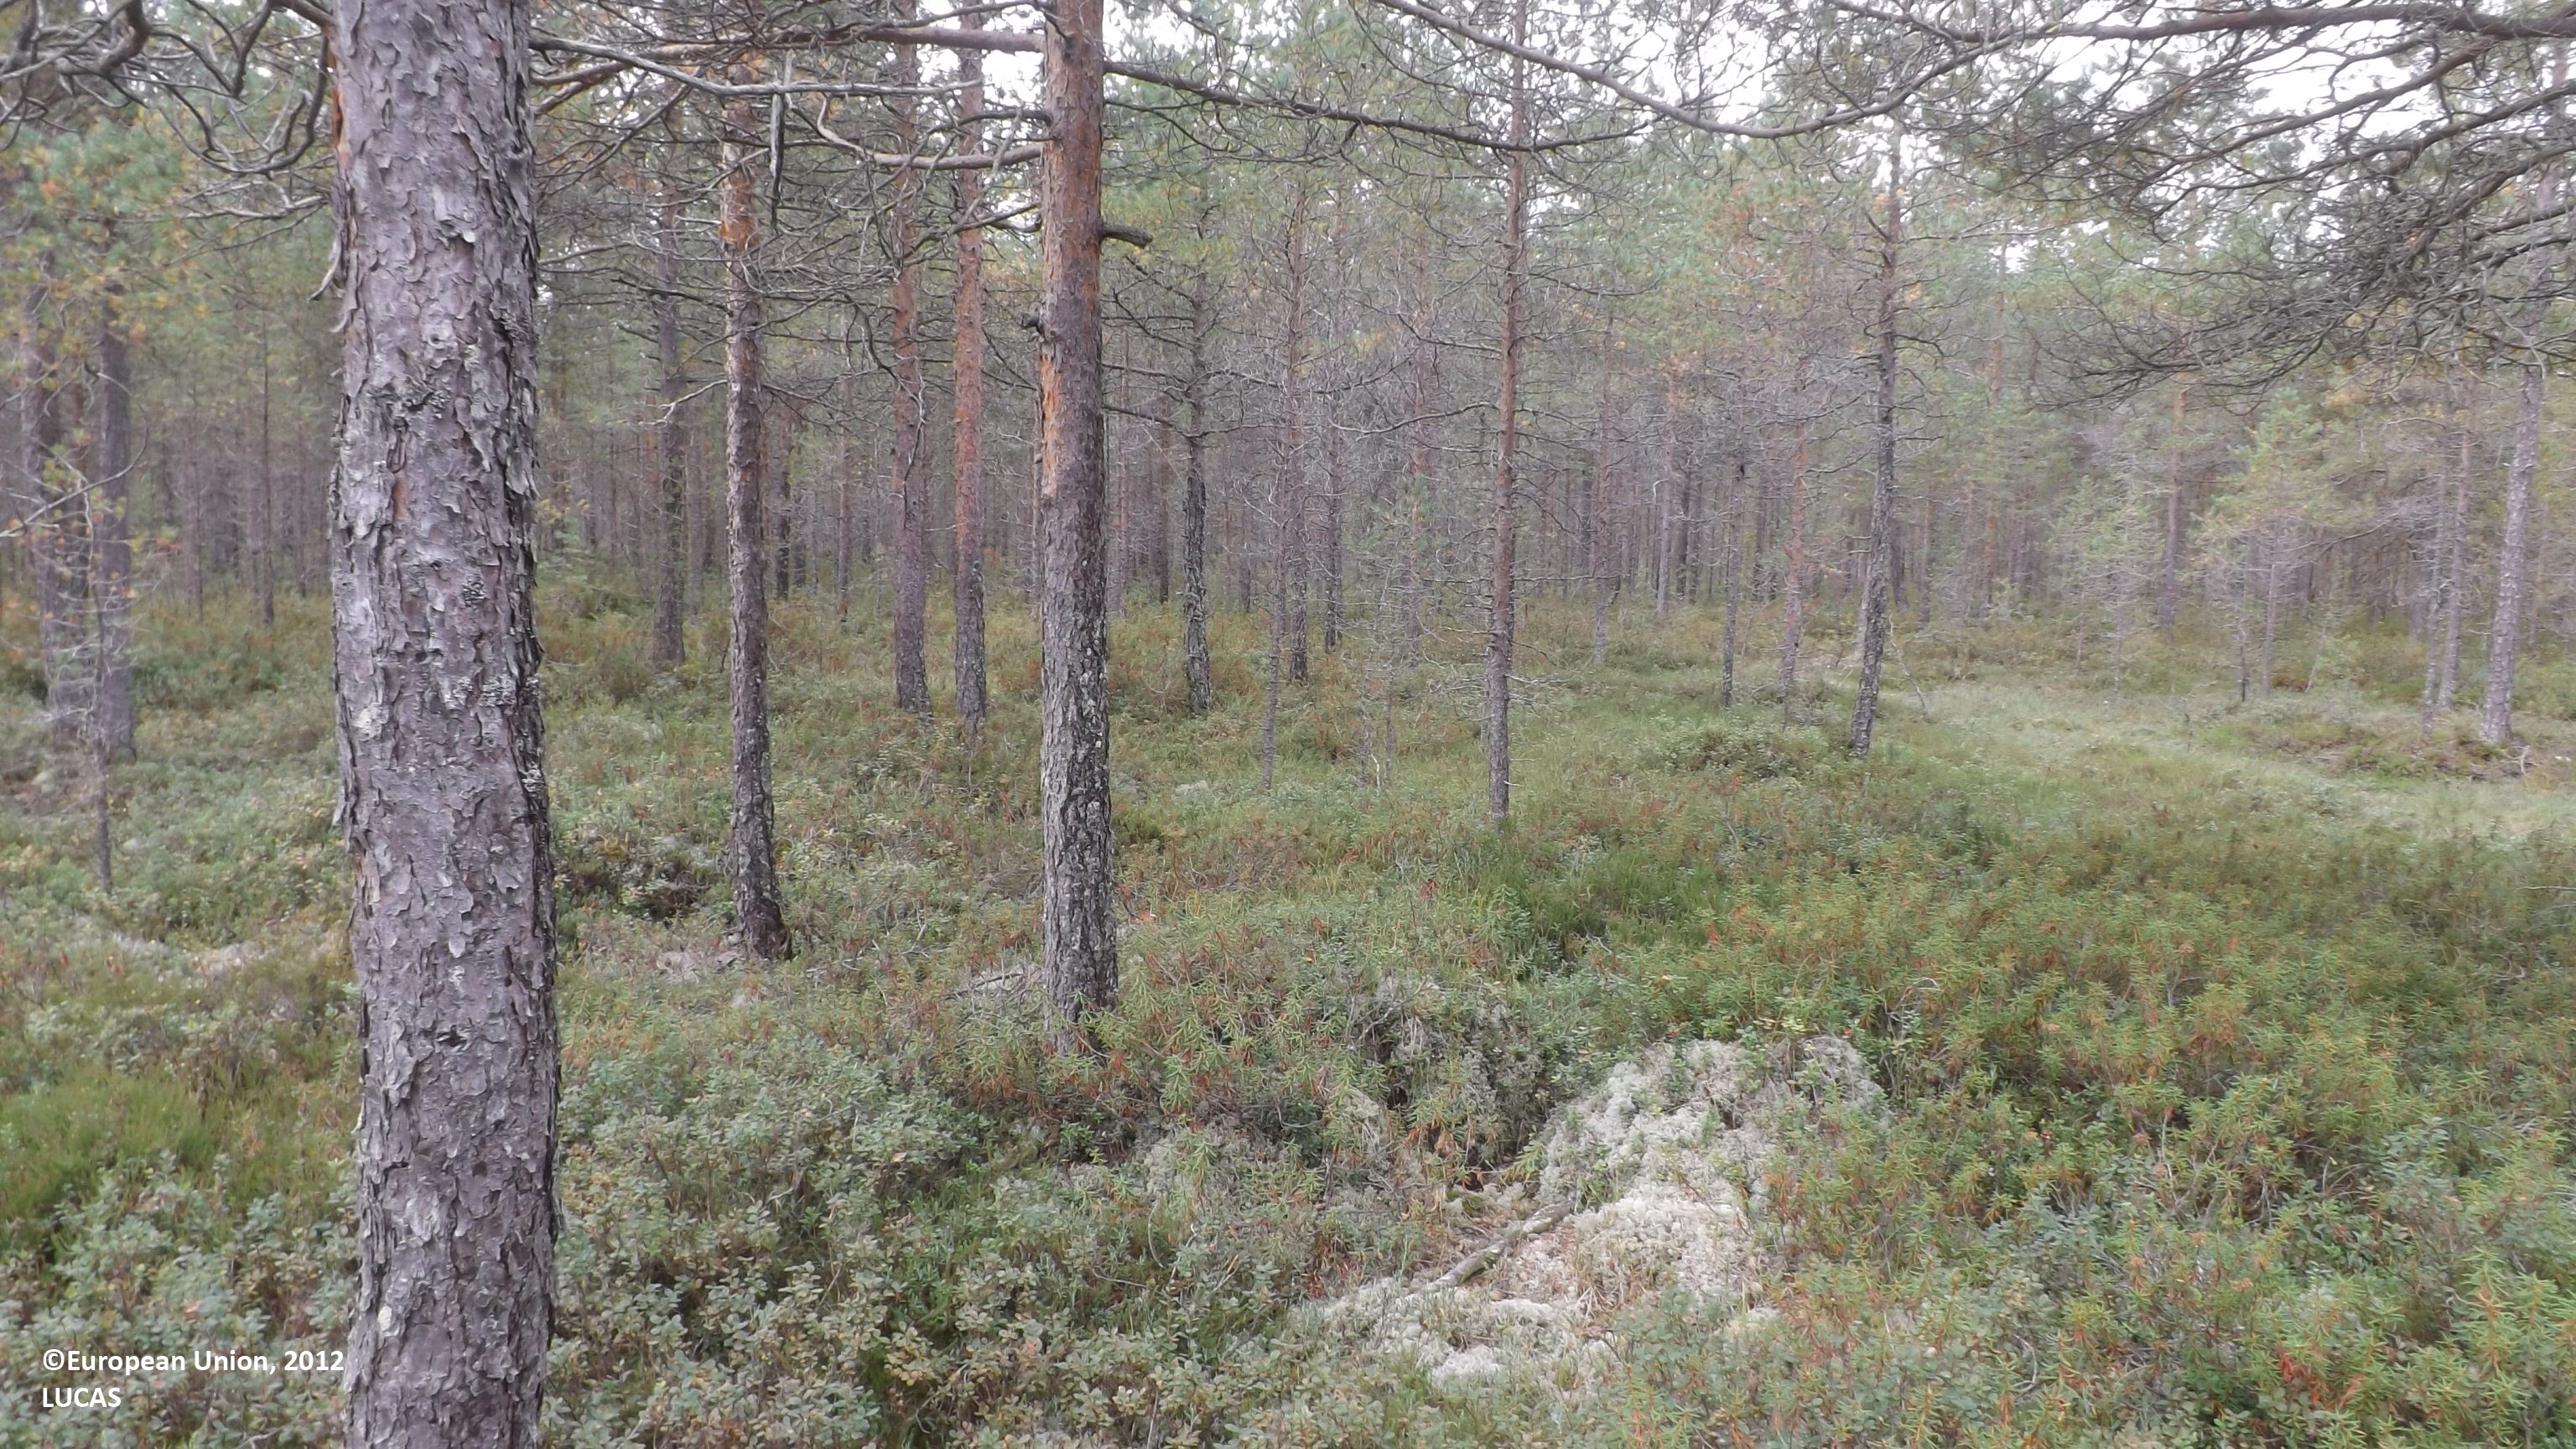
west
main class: Woodland
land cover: Pine dominated coniferous woodland
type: boreal forest
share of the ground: 25 - 50 %
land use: Forestry
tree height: > 5 m
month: August
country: FI
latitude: 63.9005
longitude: 23.6081
